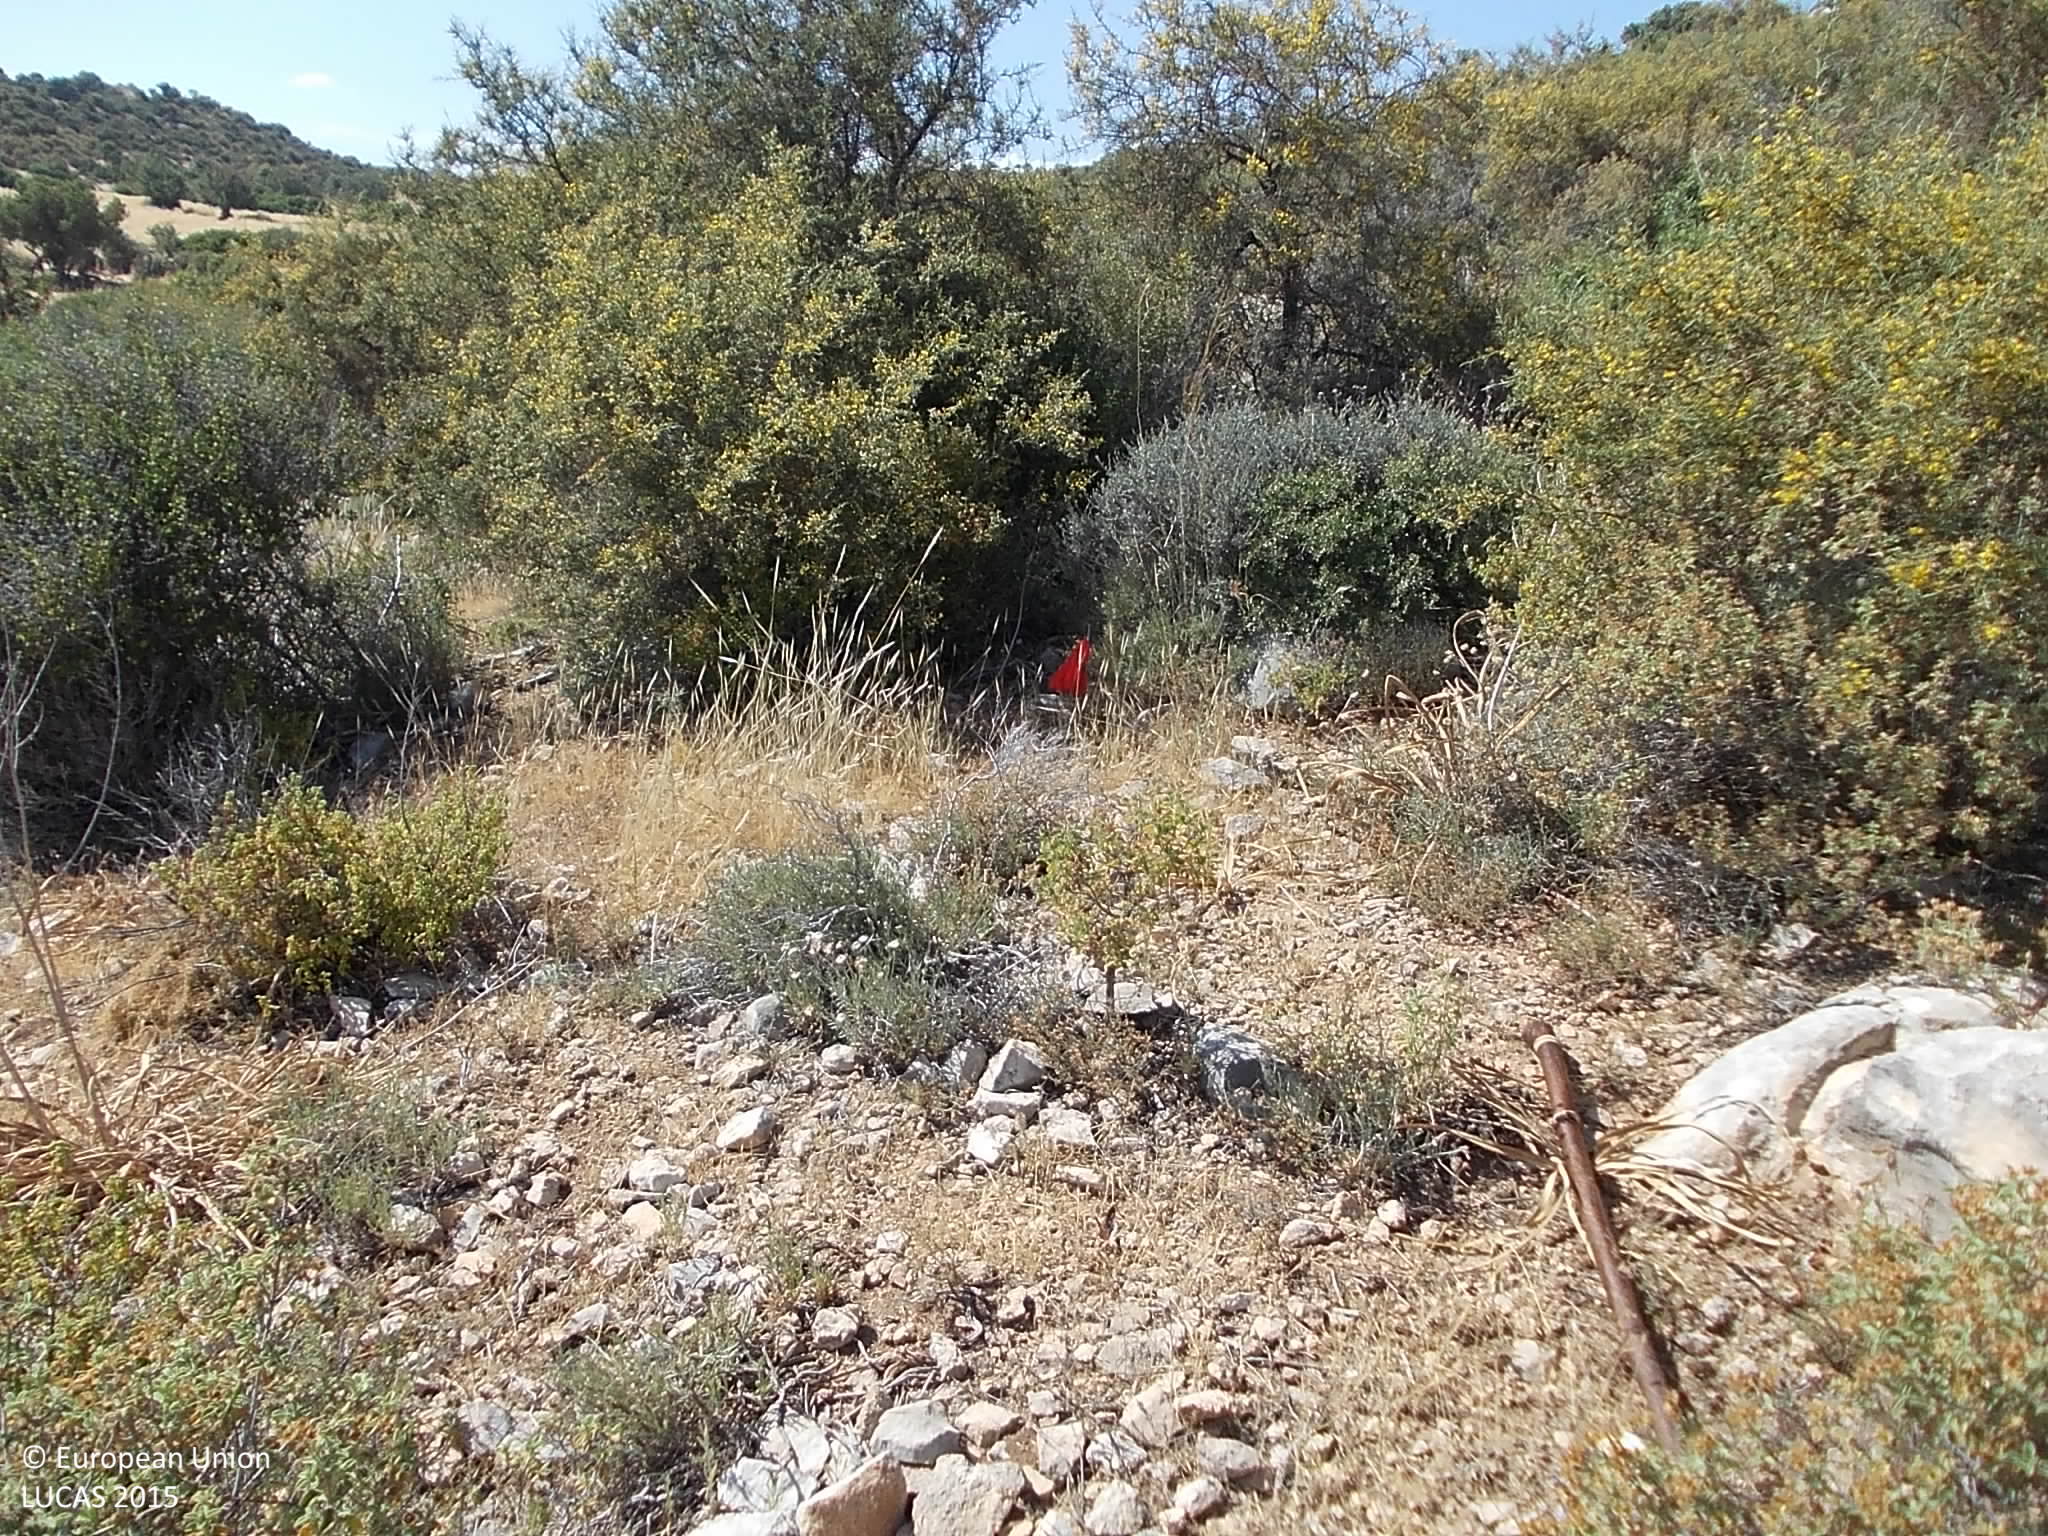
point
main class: Shrubland
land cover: Shrubland with sparse tree cover
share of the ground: > 75 %
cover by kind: shrubs 75 %, unconsolidated bare surface 20 %, broadleaved forest trees 5 %
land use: Semi-natural and natural areas not in use
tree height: < 5 m
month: May
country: CY
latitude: 34.7197
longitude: 32.9973
